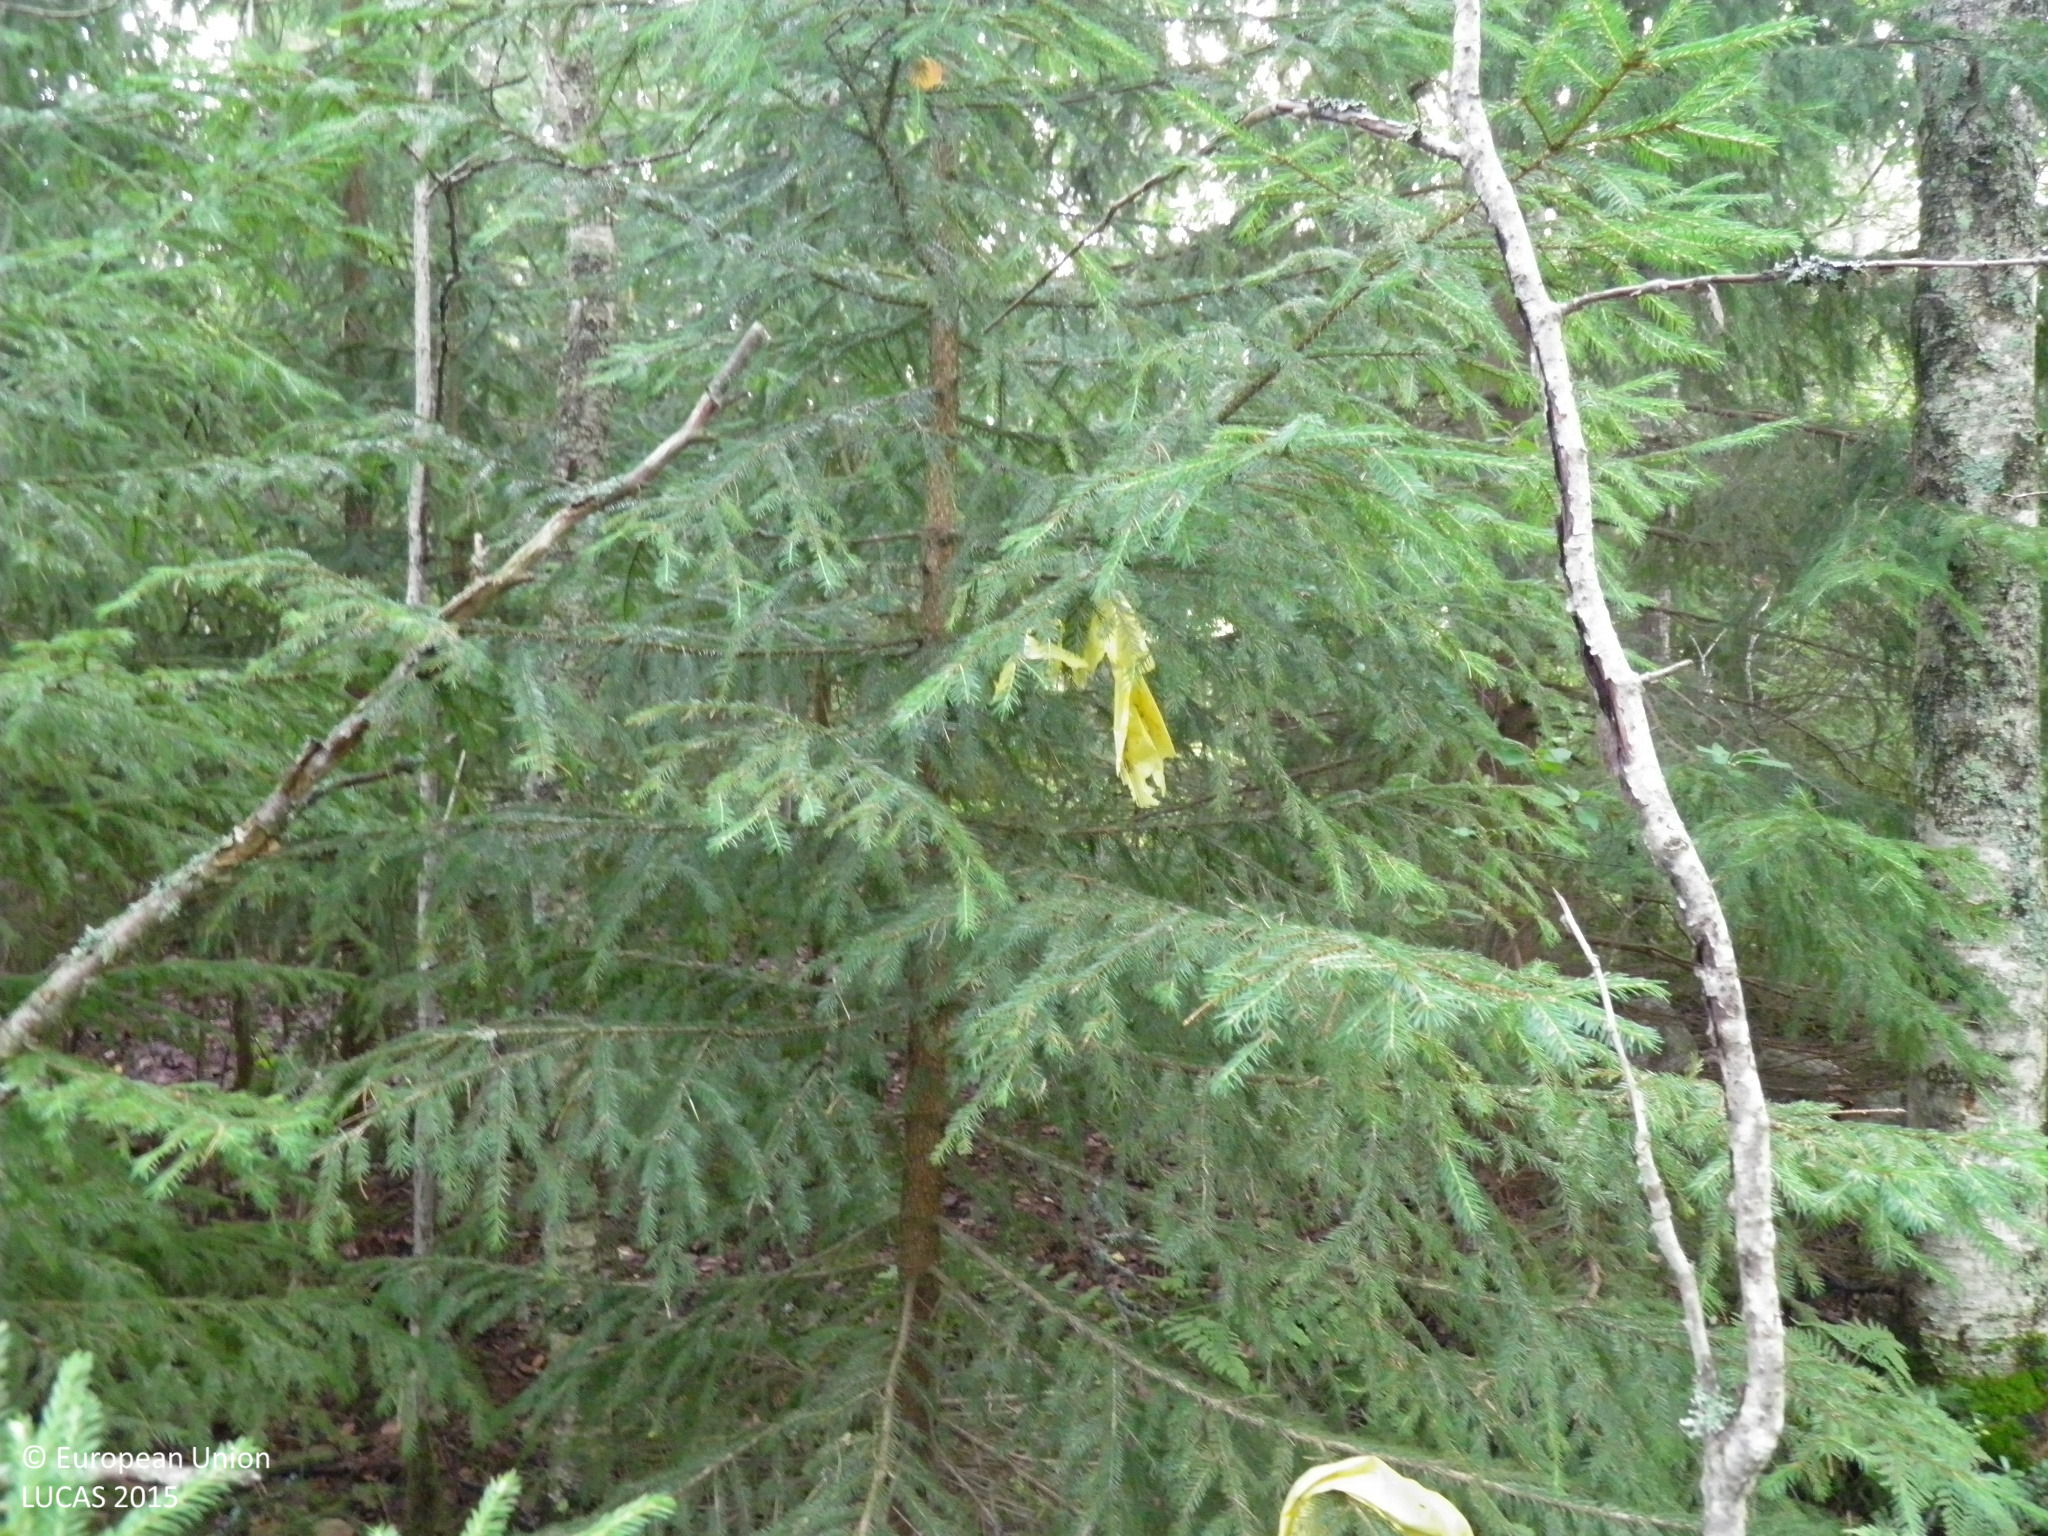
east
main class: Woodland
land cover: Pine dominated mixed woodland
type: hemiboreal forest and nemoral coniferous forest and mixed broadleaved-coniferous forest
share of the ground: > 75 %
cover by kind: broadleaved forest trees 45 %, coniferous forest trees 35 %, shrubs 10 %, herbaceous plants 5 %, lichens and mosses 5 %
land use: Forestry
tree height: > 5 m
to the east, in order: Pine dominated mixed woodland; Ditches and canals; Other mixed woodland; Pine dominated coniferous woodland; Spruce dominated coniferous woodland; Ditches and canals; Spruce dominated coniferous woodland; Spruce dominated mixed woodland
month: July
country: FI
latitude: 60.0921
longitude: 22.7527
